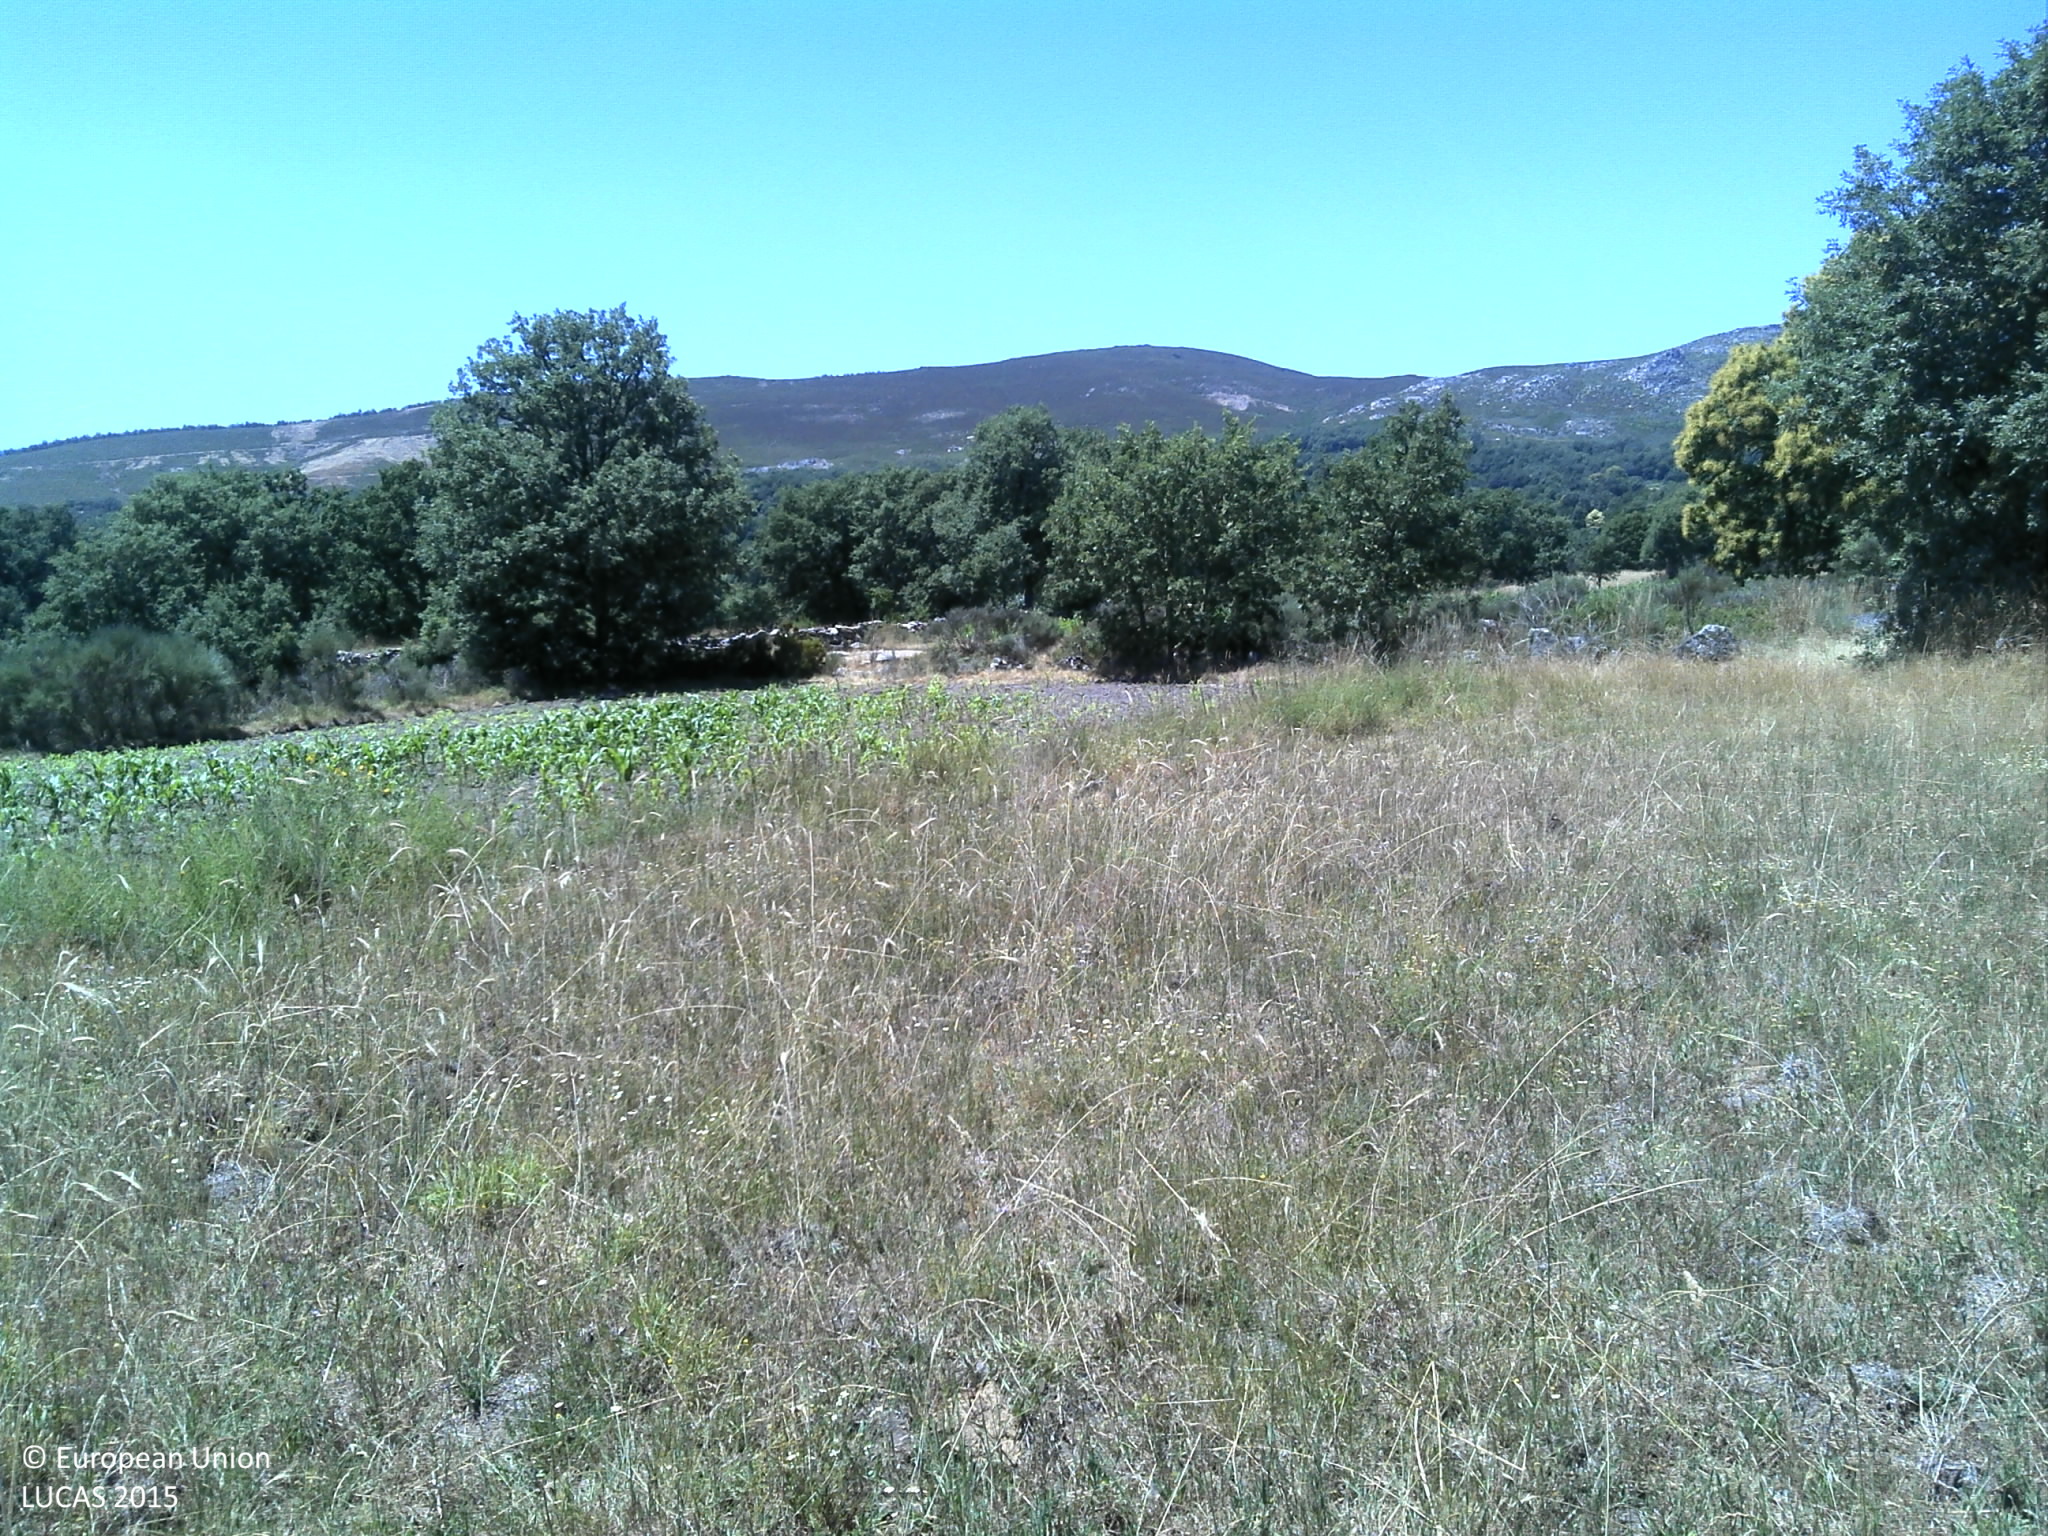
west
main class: Grassland
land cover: Grassland without tree/shrub cover
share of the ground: > 75 %
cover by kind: herbaceous plants 95 %, unconsolidated bare surface 5 %
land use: Agriculture (excluding fallow land and kitchen gardens)
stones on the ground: < 10 %
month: July
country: PT
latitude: 41.8089
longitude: -7.6496
